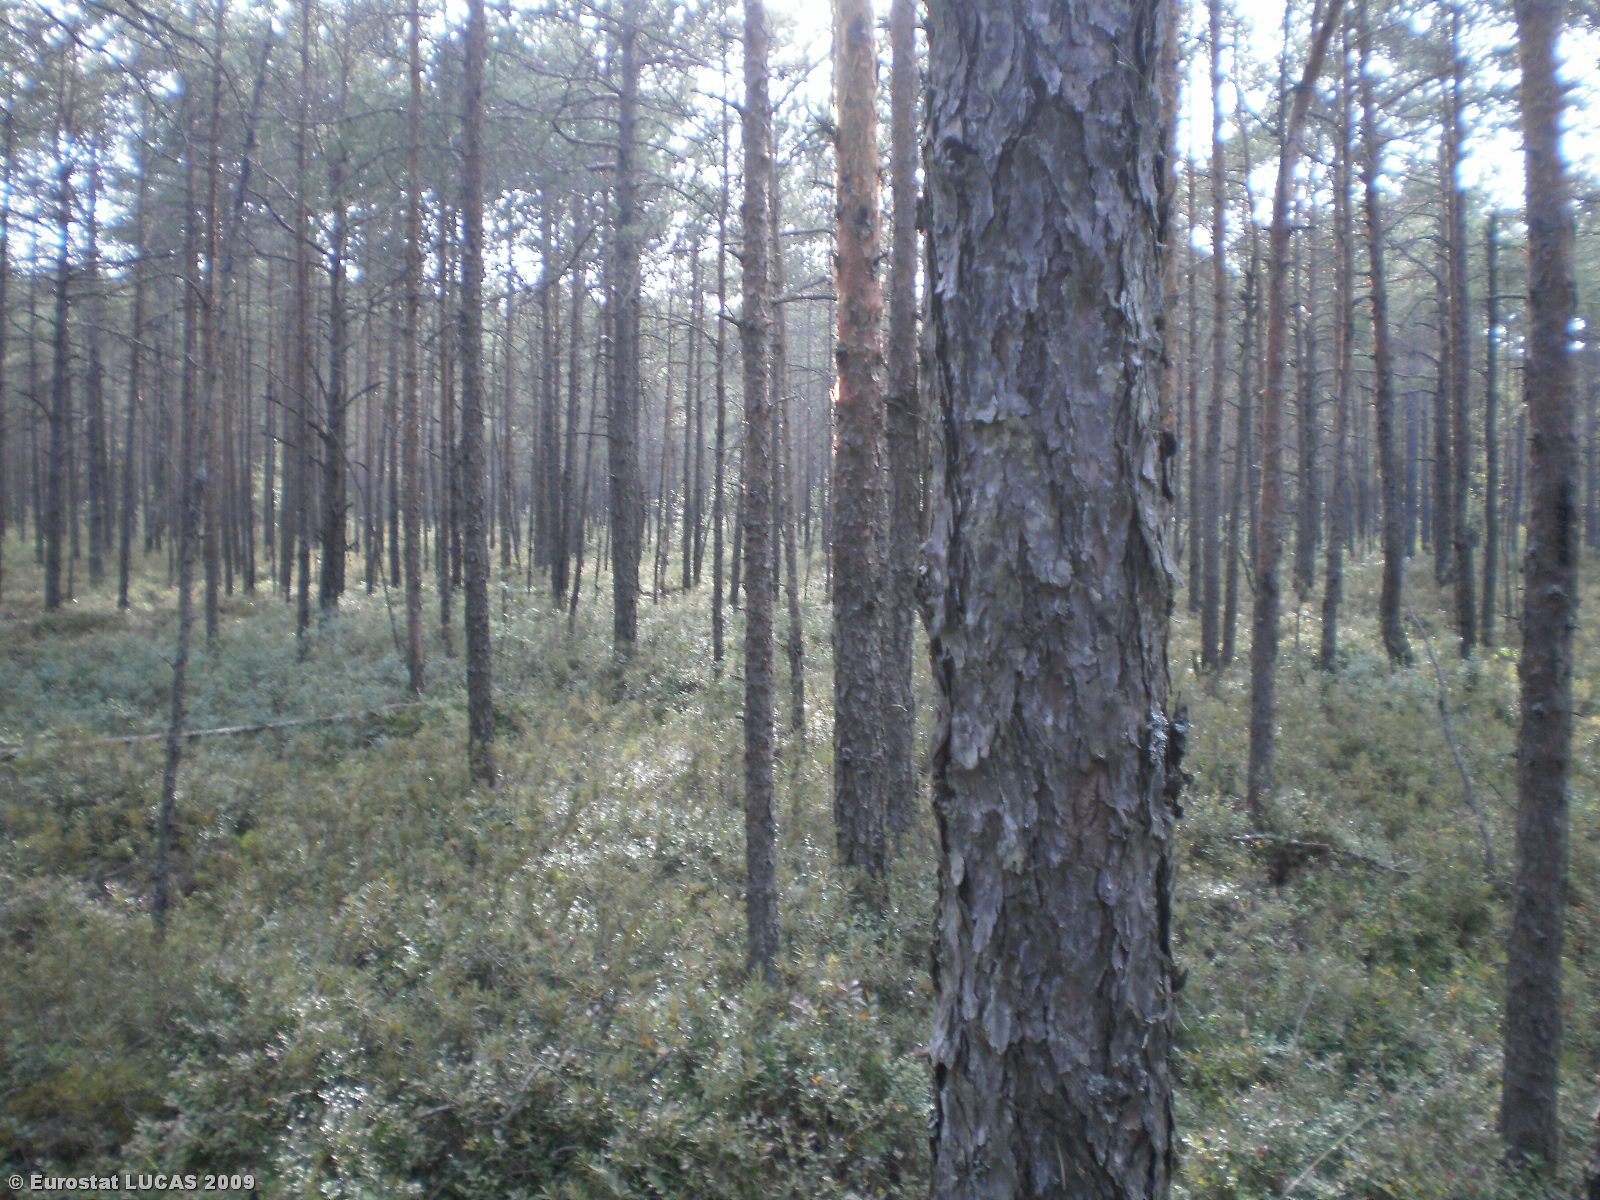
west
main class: Woodland
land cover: Coniferous woodland
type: hemiboreal forest and nemoral coniferous forest and mixed broadleaved-coniferous forest
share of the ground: > 75 %
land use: Forestry
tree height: > 5 m
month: July
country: LT
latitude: 55.7709
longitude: 25.6370
